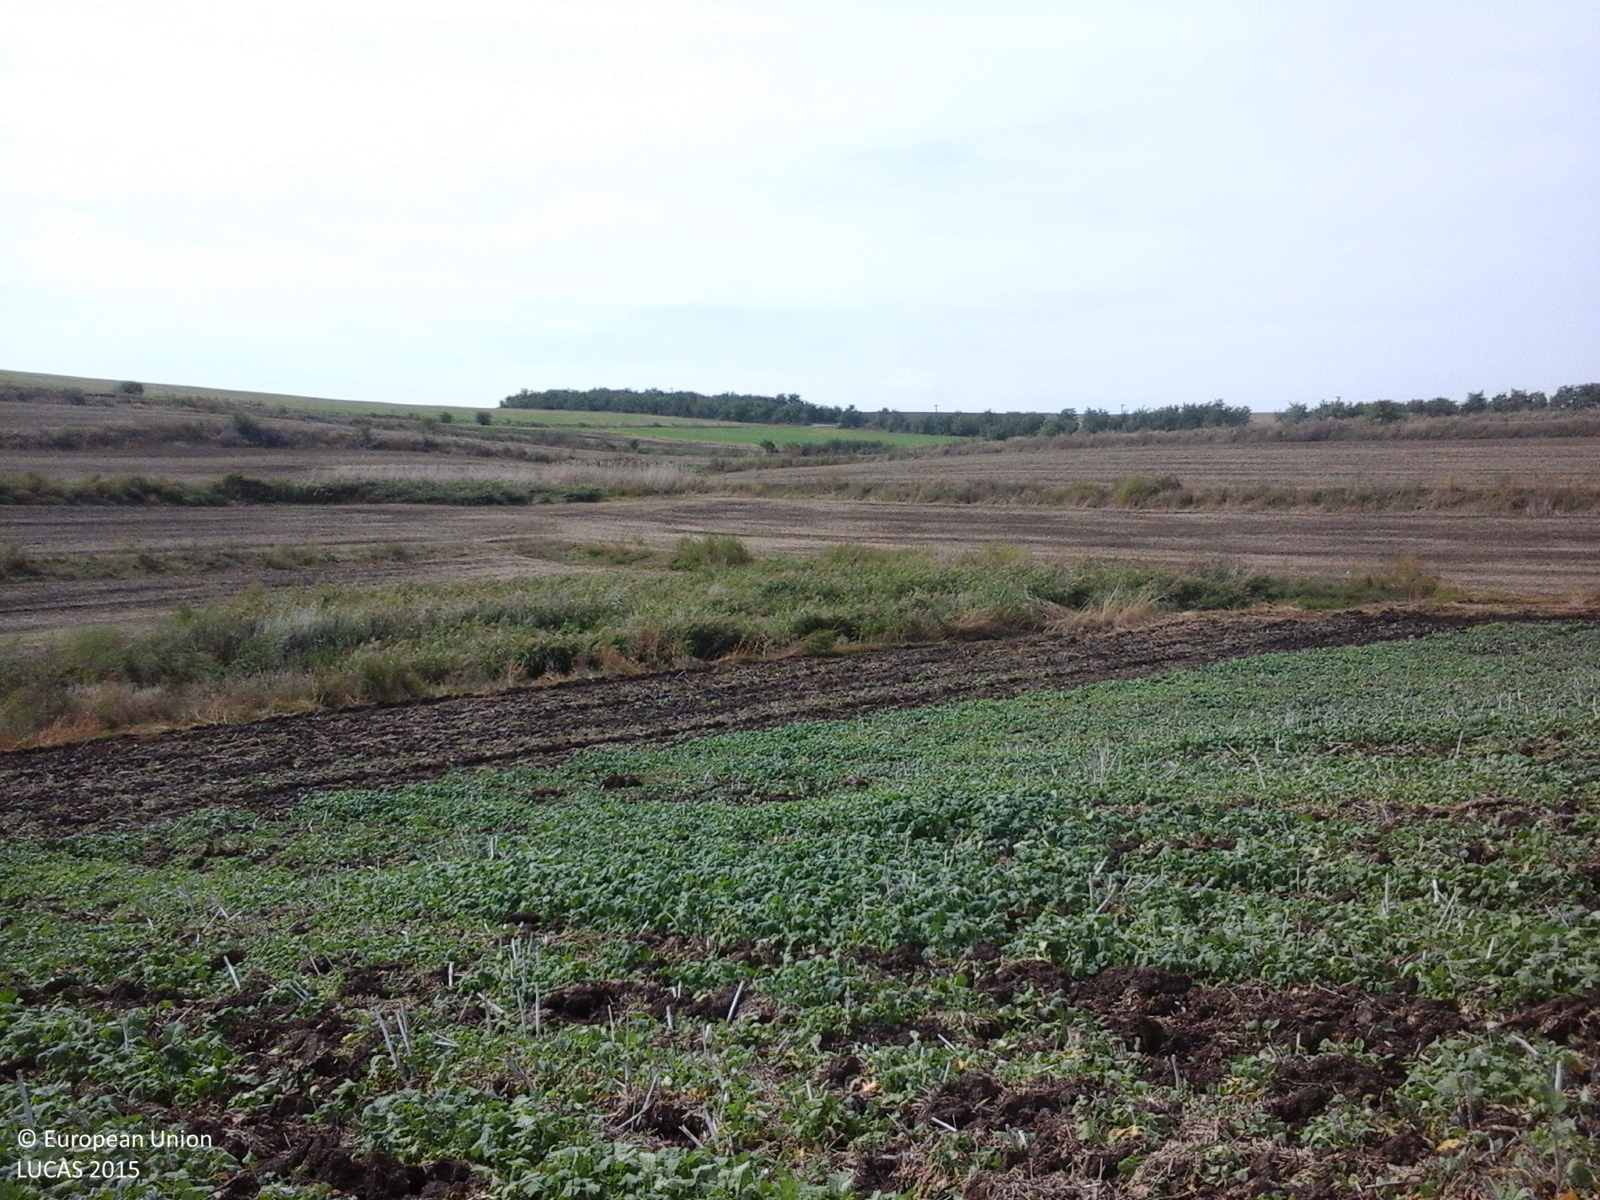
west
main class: Cropland
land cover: Rape and turnip rape
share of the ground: 25 - 50 %
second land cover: Spontaneously vegetated surfaces
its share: 50 - 75 %
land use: Agriculture (excluding fallow land and kitchen gardens)
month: September
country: RO
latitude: 46.6203
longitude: 23.7990
